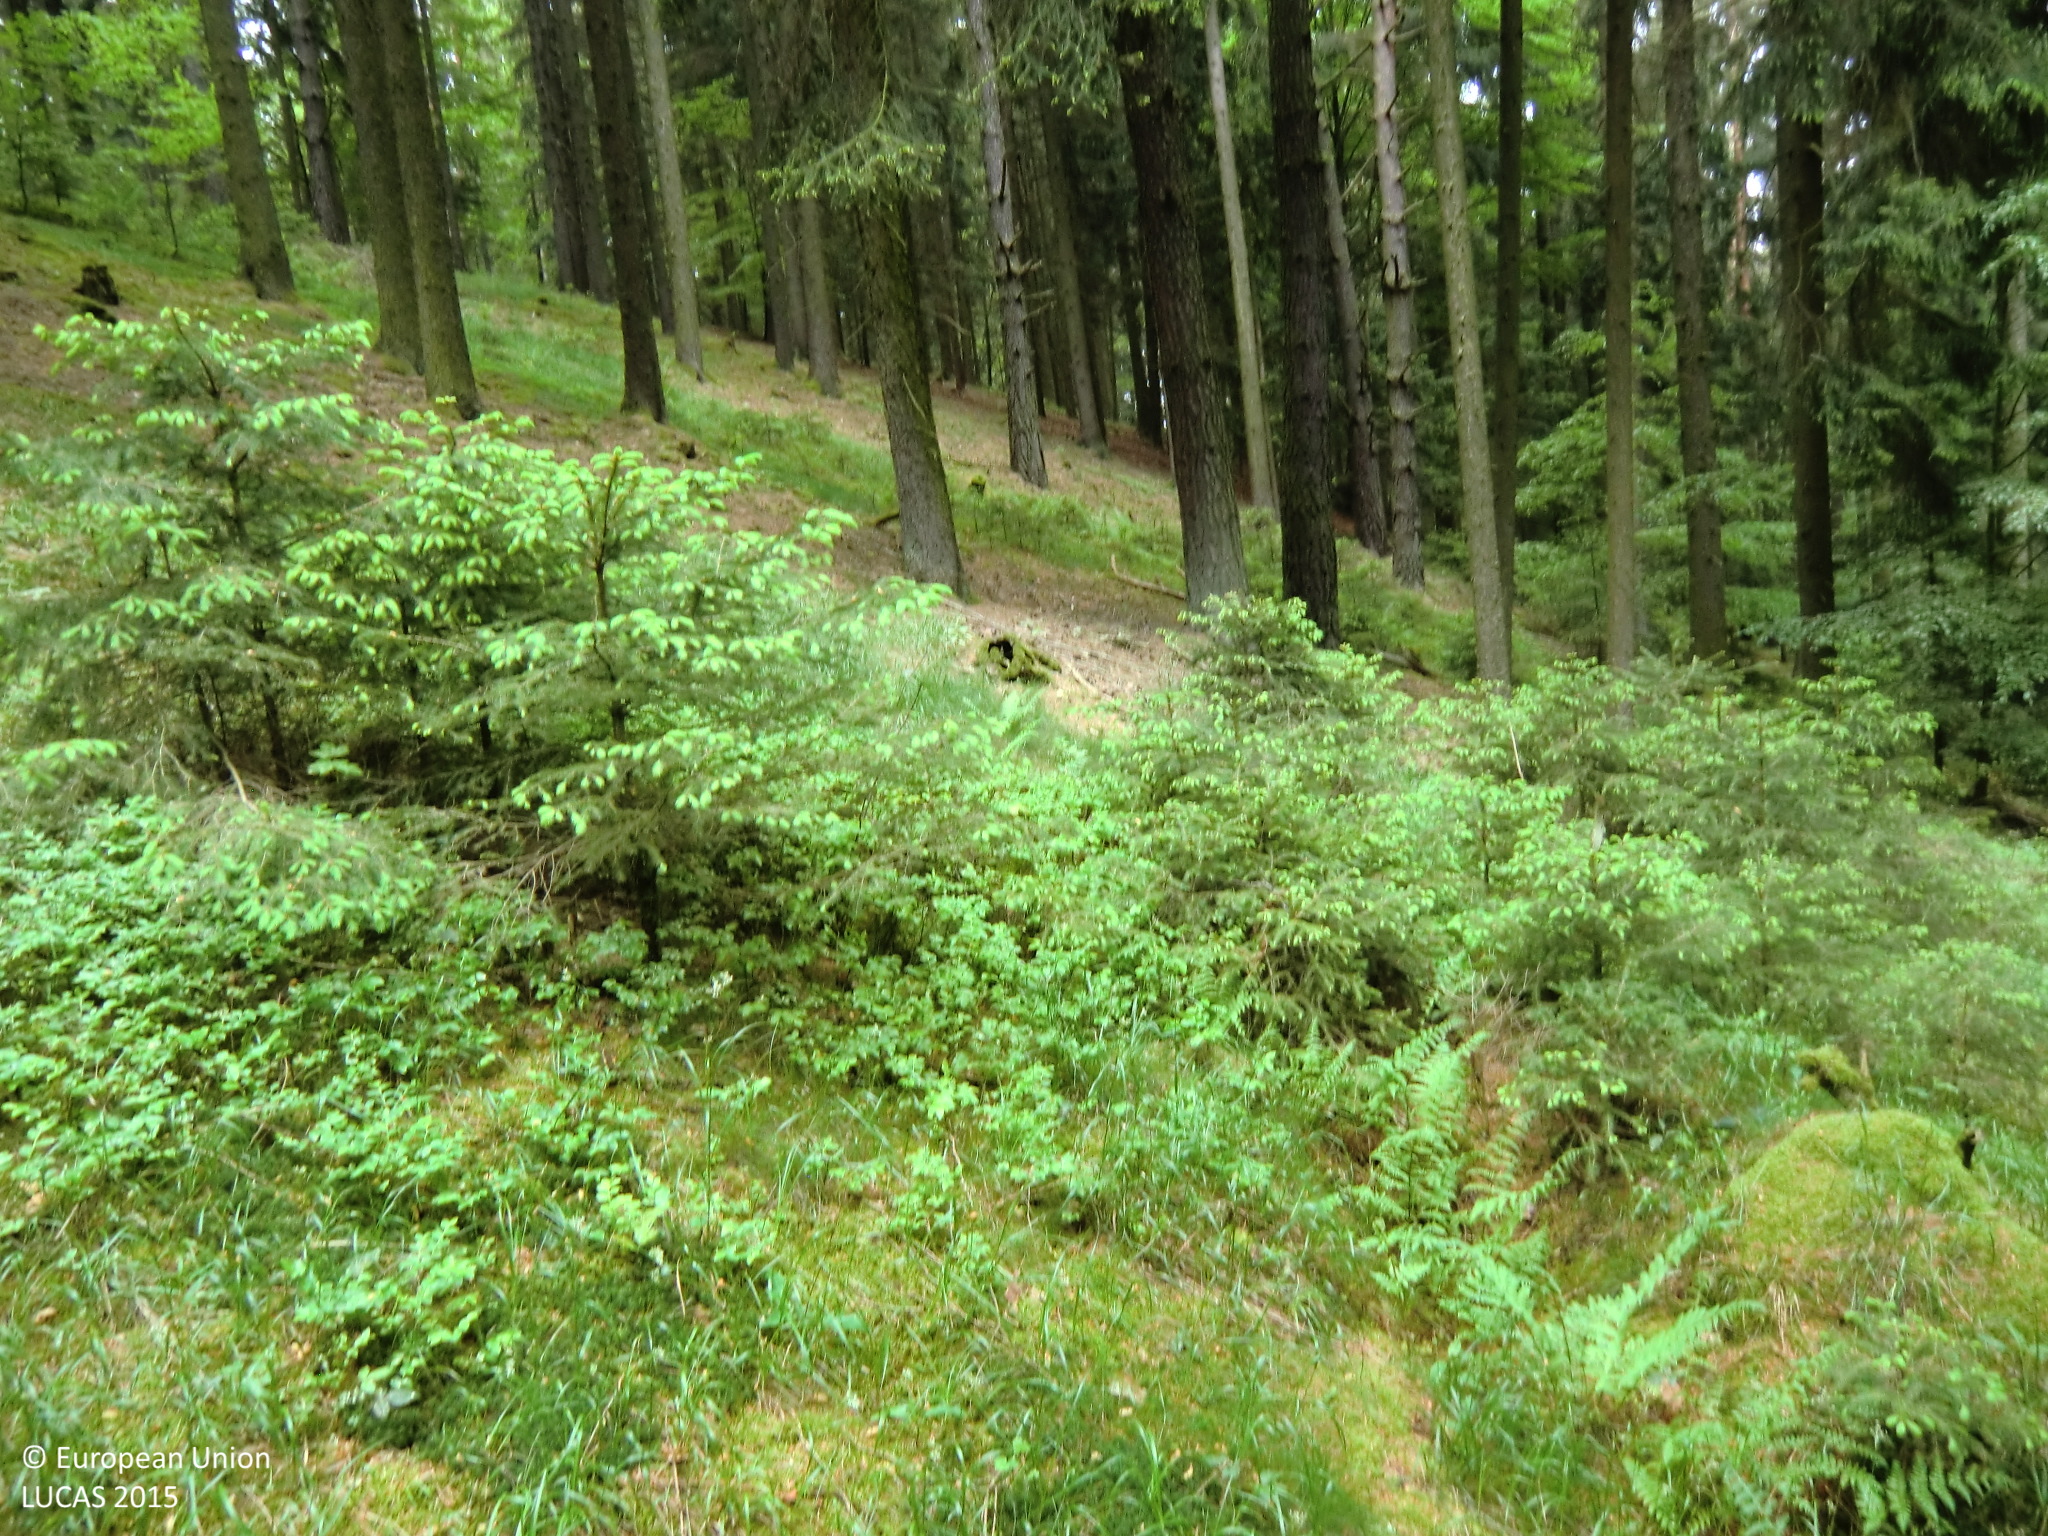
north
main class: Woodland
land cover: Spruce dominated coniferous woodland
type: alpine coniferous forest
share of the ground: > 75 %
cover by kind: coniferous forest trees 65 %, lichens and mosses 25 %, consolidated bare surface 10 %
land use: Forestry
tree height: > 5 m
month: May
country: AT
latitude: 48.4064
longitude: 14.3908
